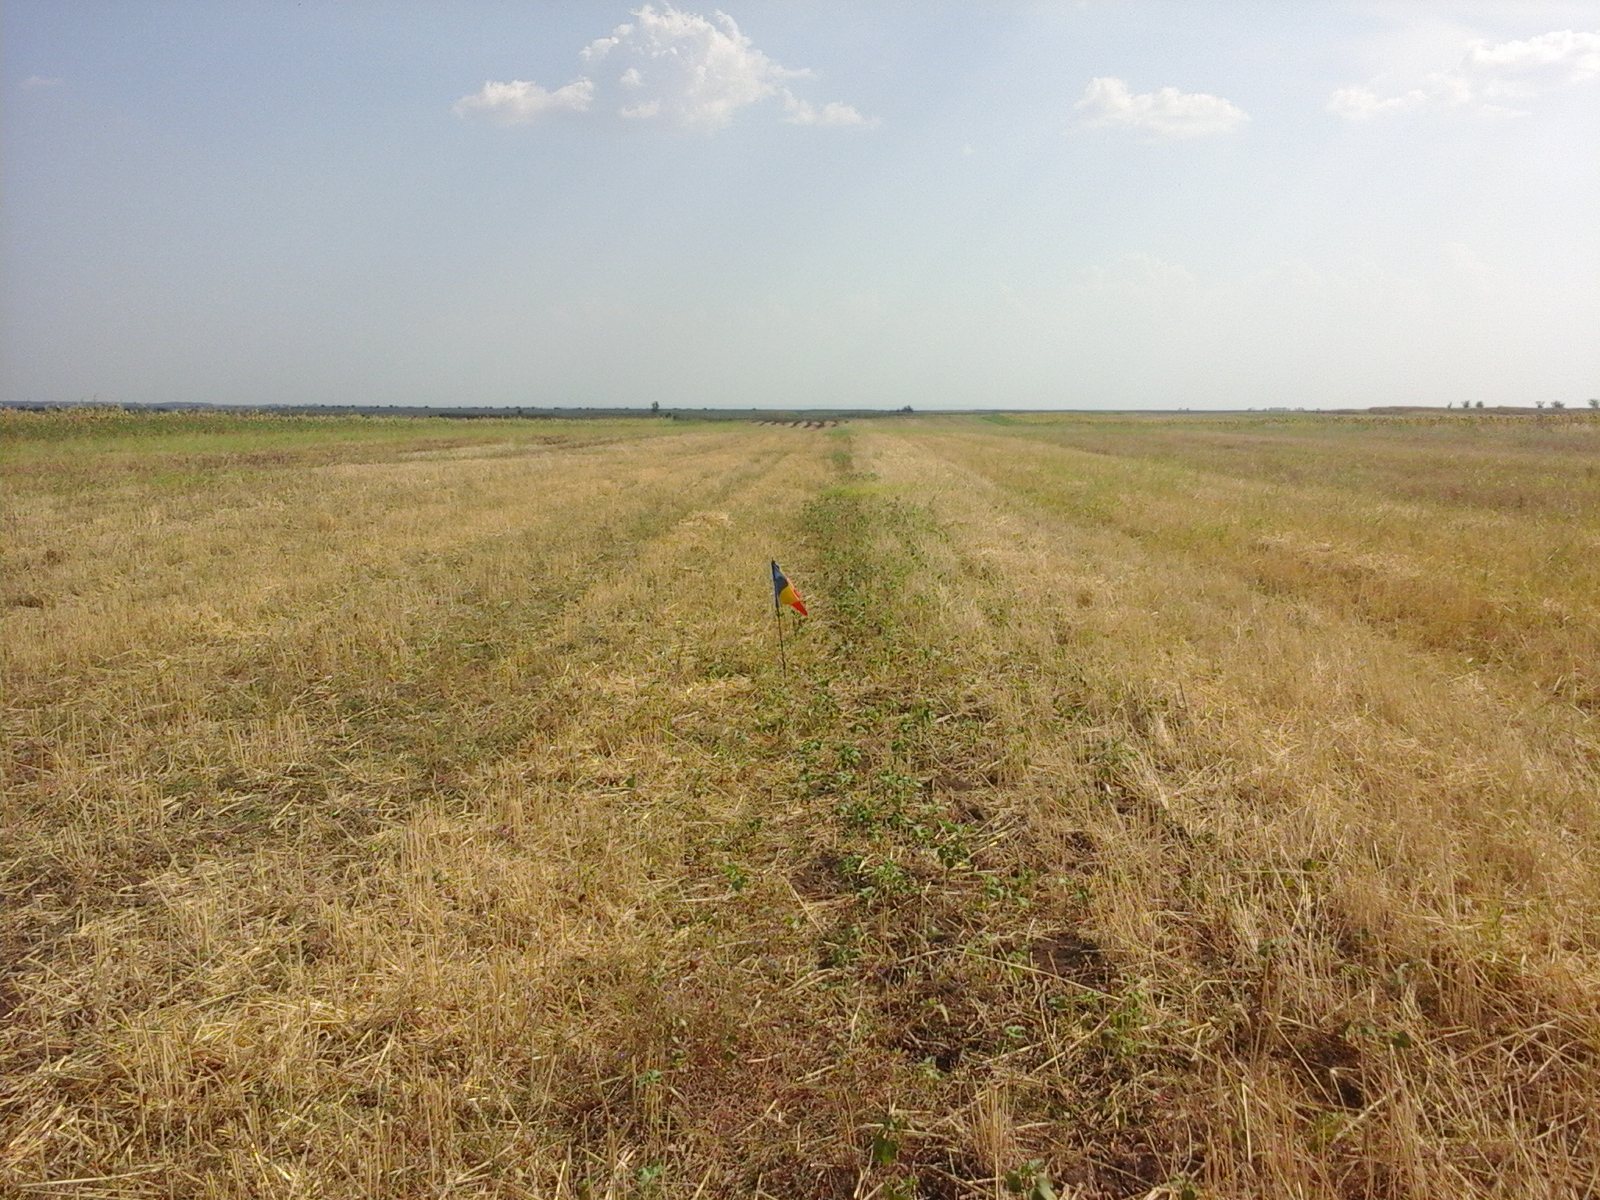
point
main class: Cropland
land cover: Common wheat
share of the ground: > 75 %
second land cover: Spontaneously vegetated surfaces
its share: 25 - 50 %
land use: Agriculture (excluding fallow land and kitchen gardens)
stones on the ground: < 10 %
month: August
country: RO
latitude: 44.0960
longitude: 23.5536
